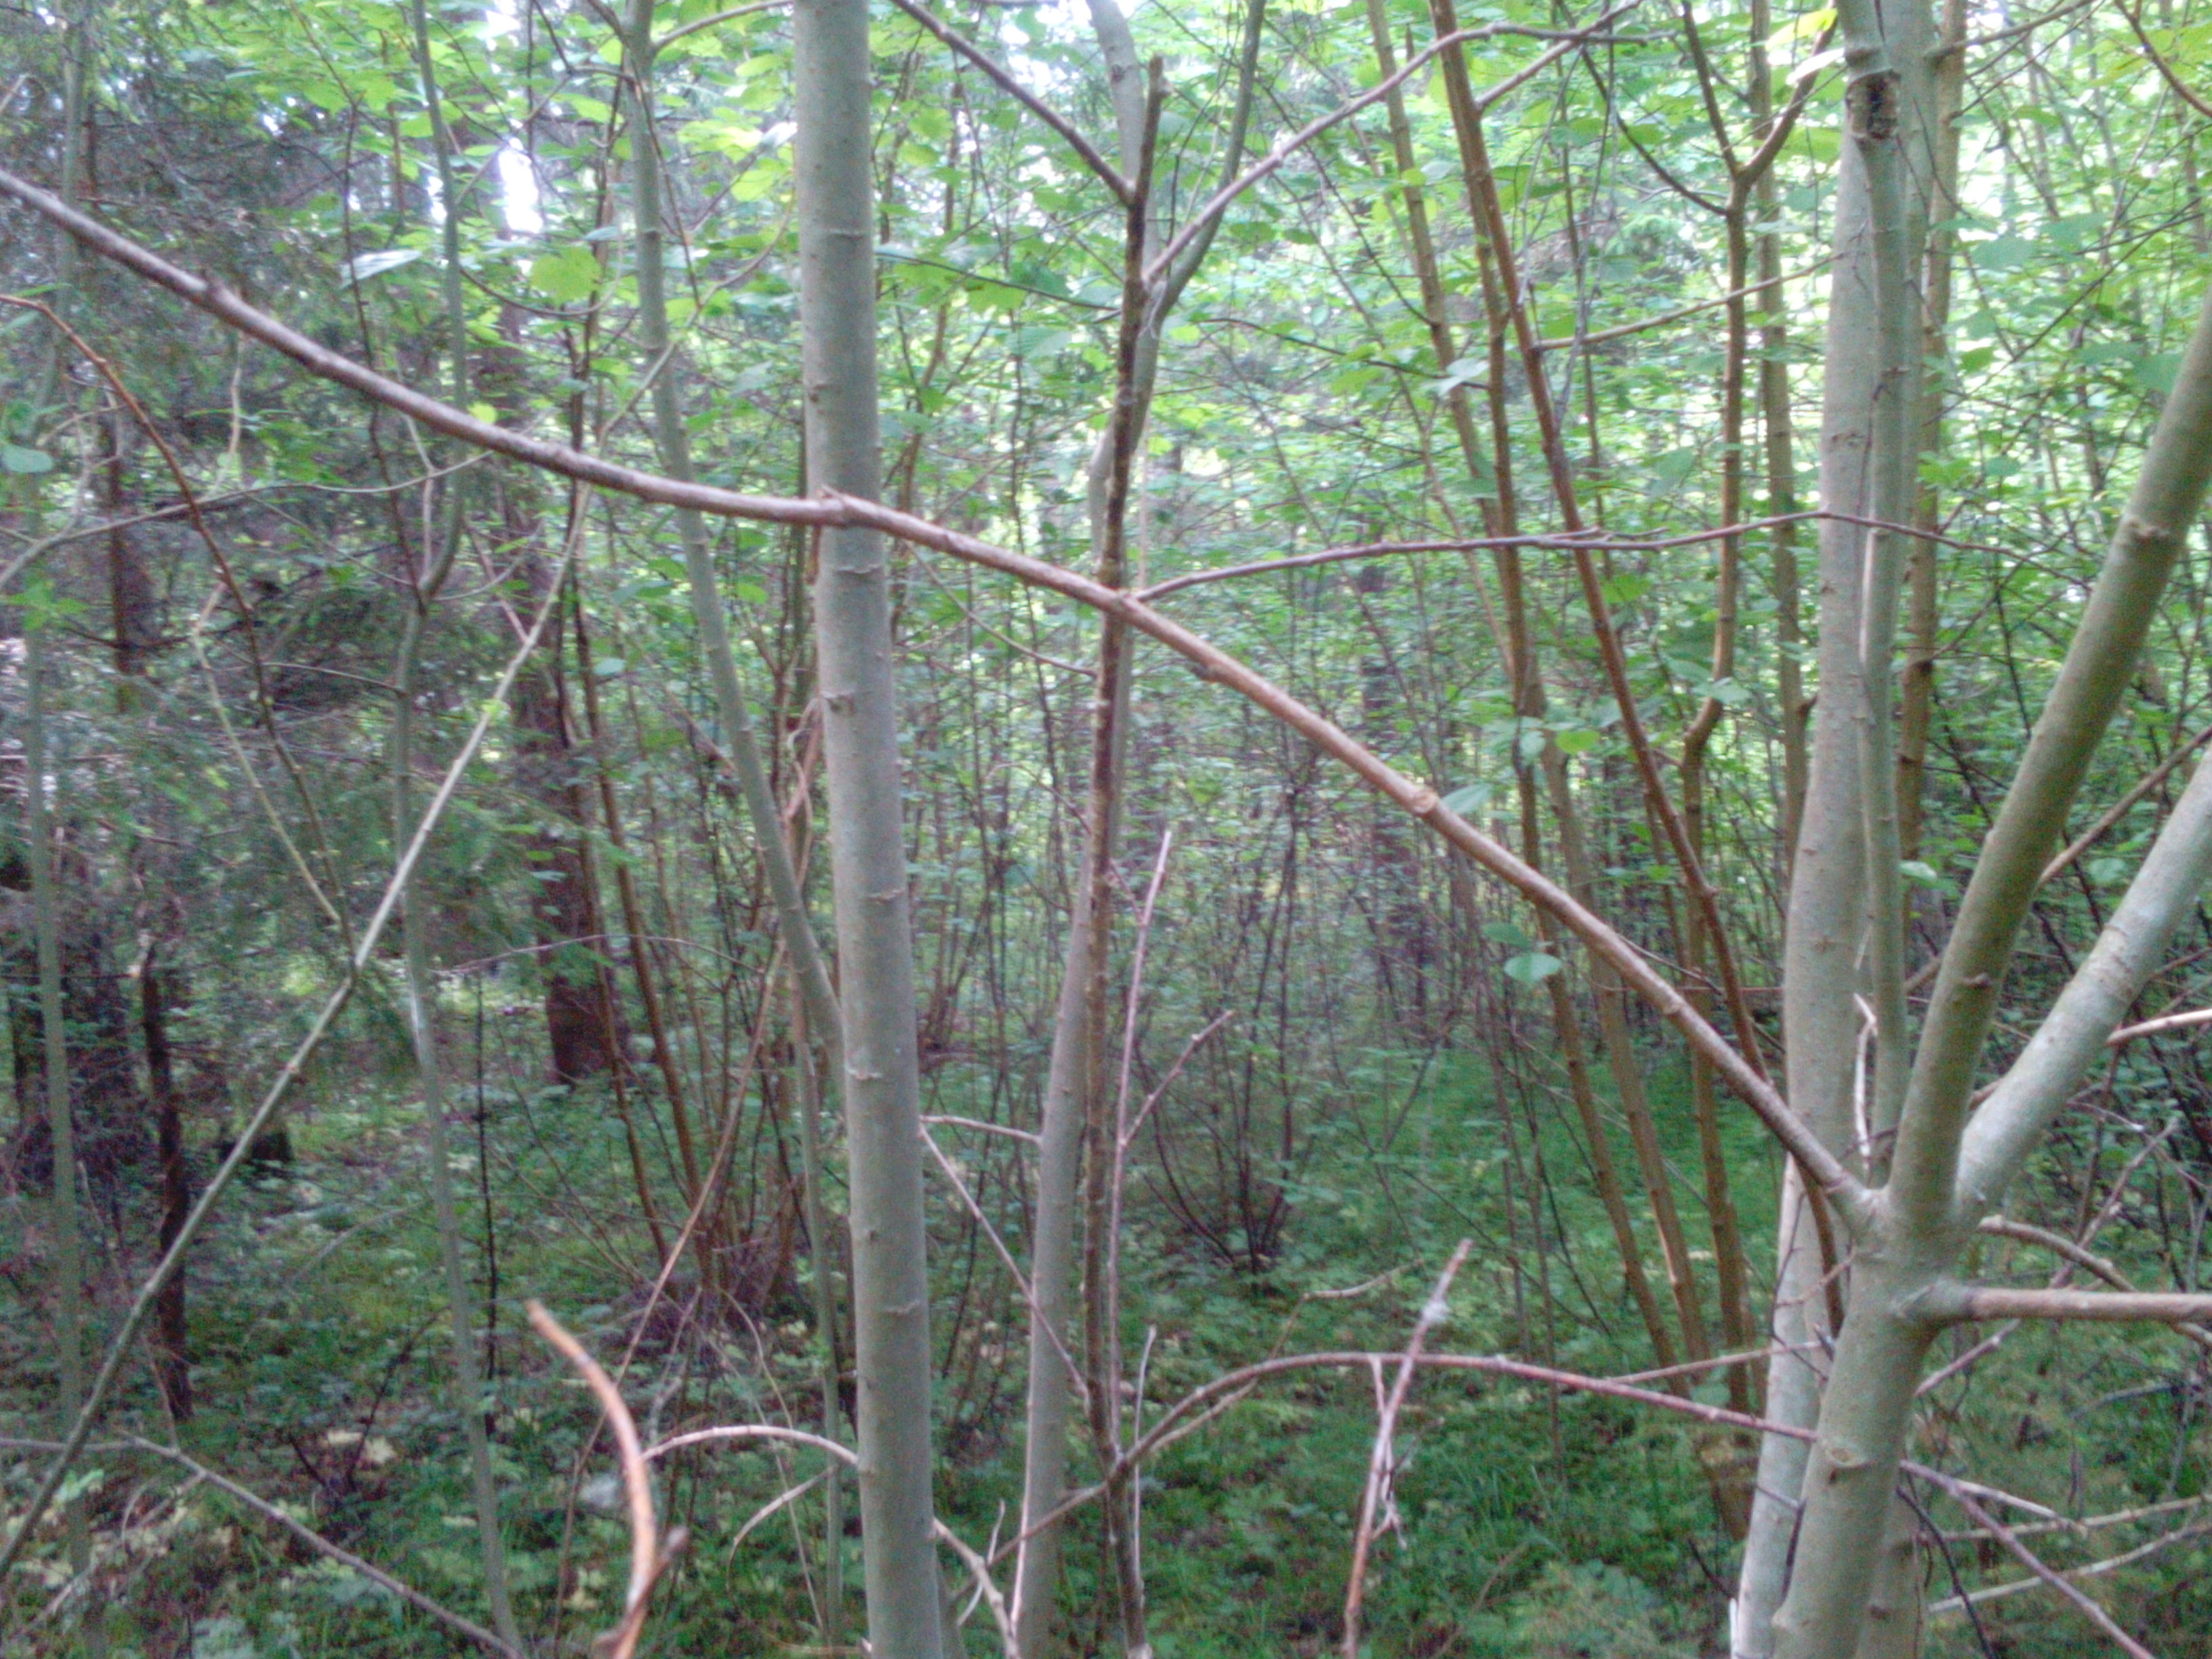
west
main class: Woodland
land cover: Spruce dominated mixed woodland
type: hemiboreal forest and nemoral coniferous forest and mixed broadleaved-coniferous forest
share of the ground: > 75 %
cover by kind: broadleaved forest trees 65 %, coniferous forest trees 35 %
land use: Forestry
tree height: > 5 m
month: June
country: LV
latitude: 56.8530
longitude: 22.2686
